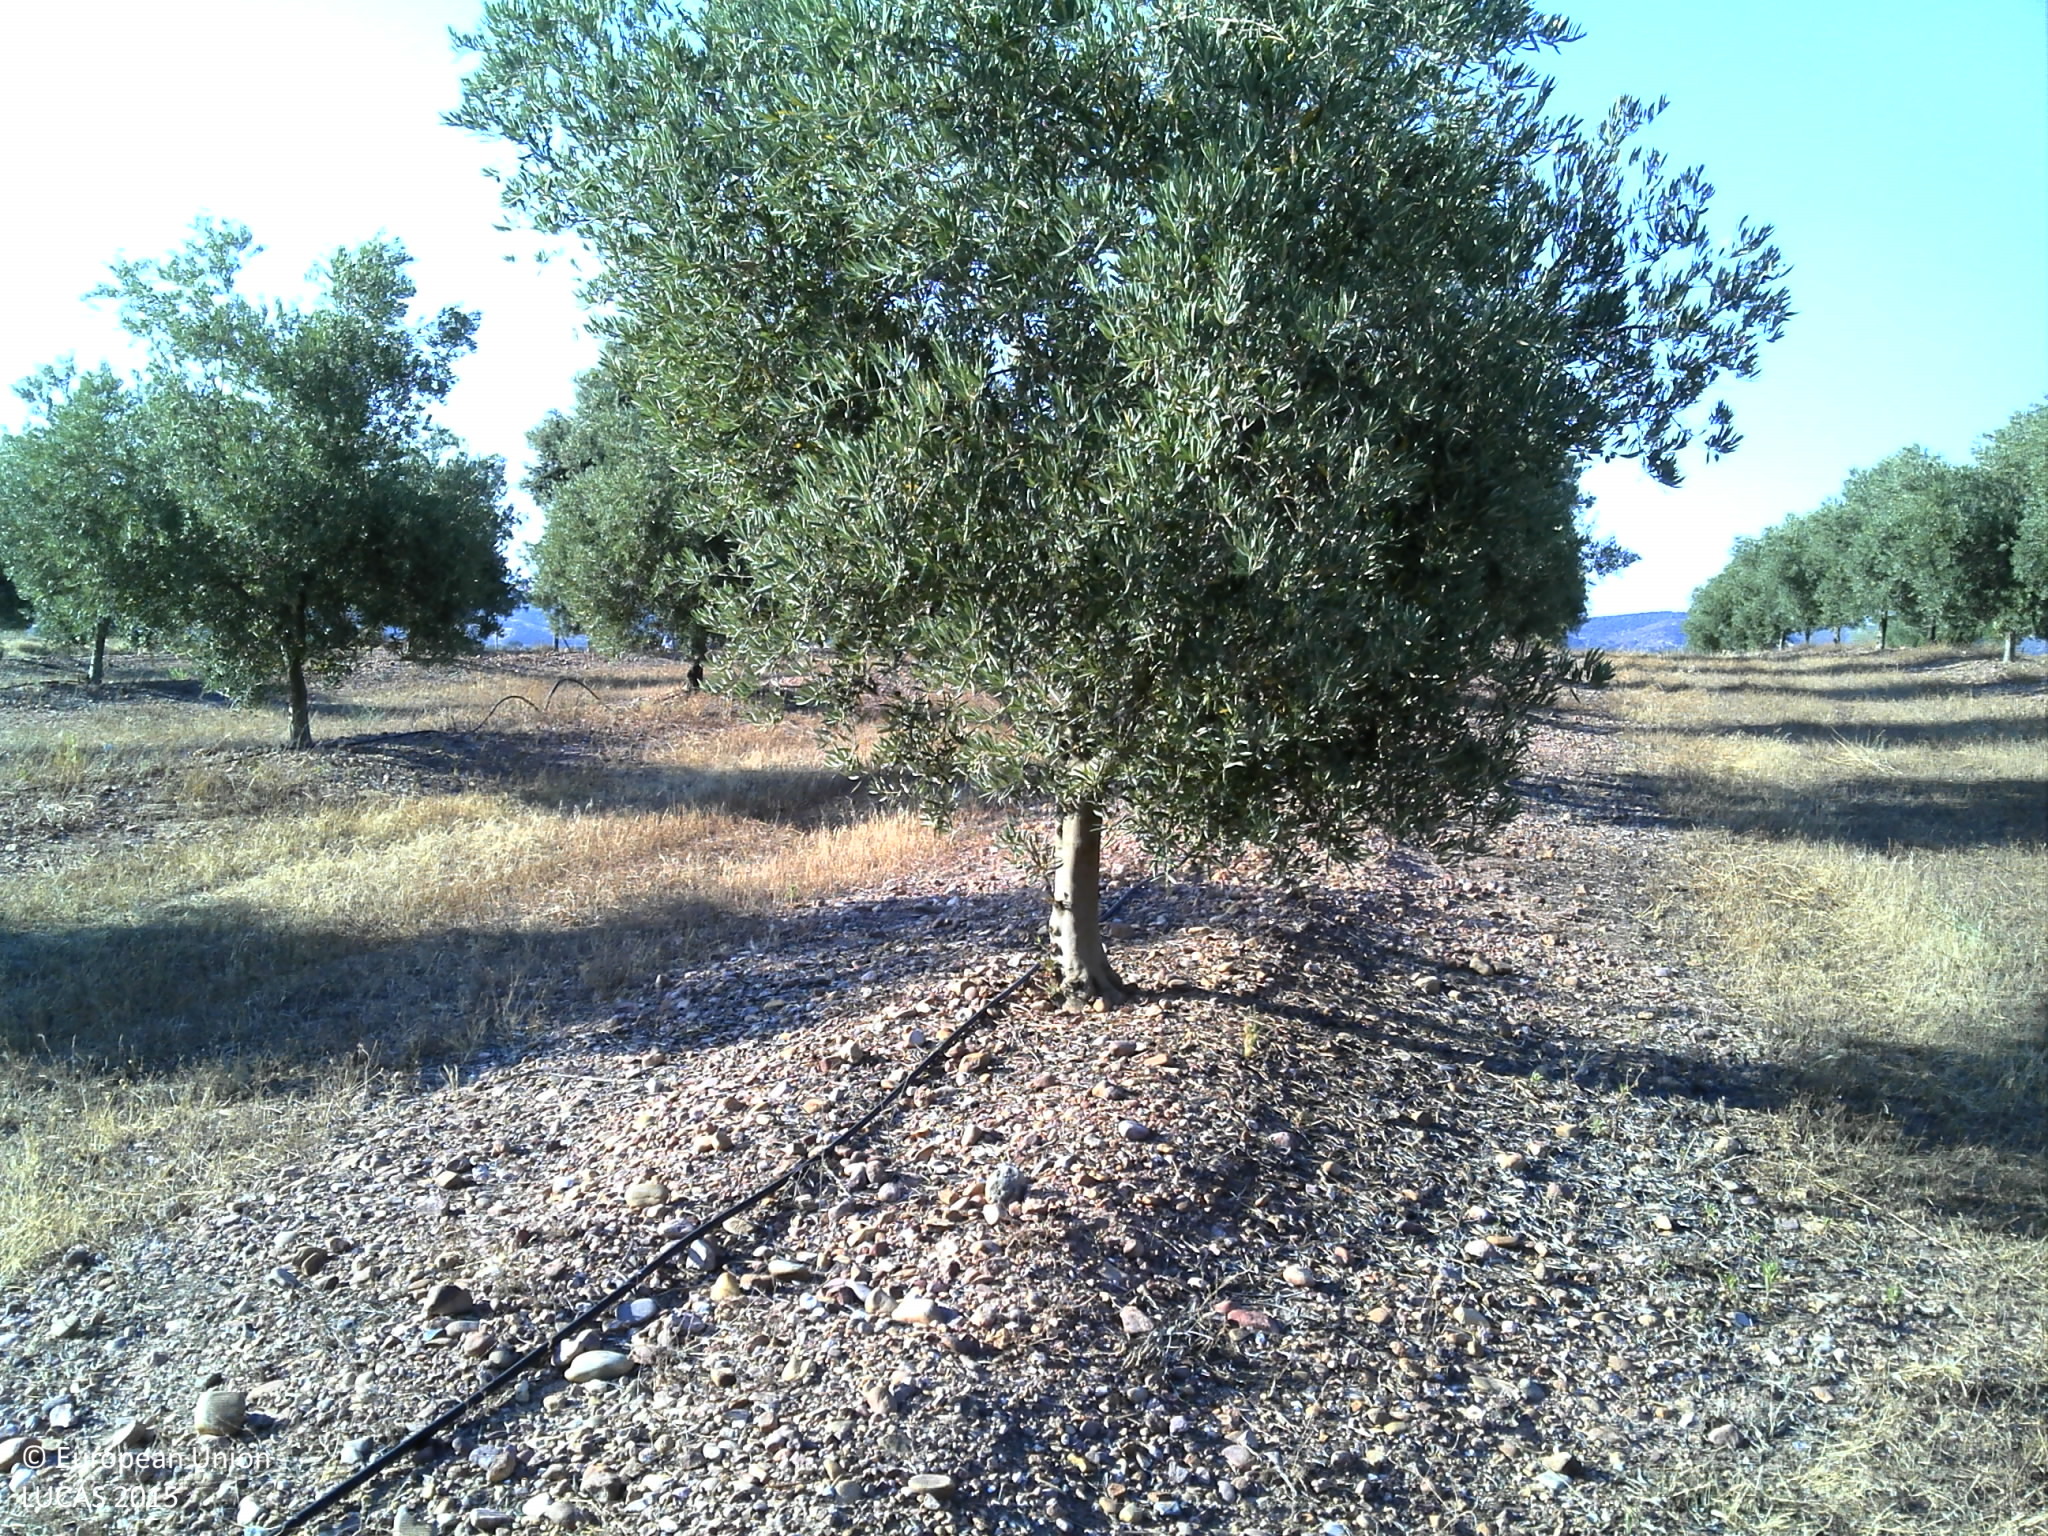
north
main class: Cropland
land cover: Olive groves
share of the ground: 25 - 50 %
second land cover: Grassland without tree/shrub cover
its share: 10 - 25 %
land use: Agriculture (excluding fallow land and kitchen gardens)
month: June
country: PT
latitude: 38.1517
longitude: -7.5630
